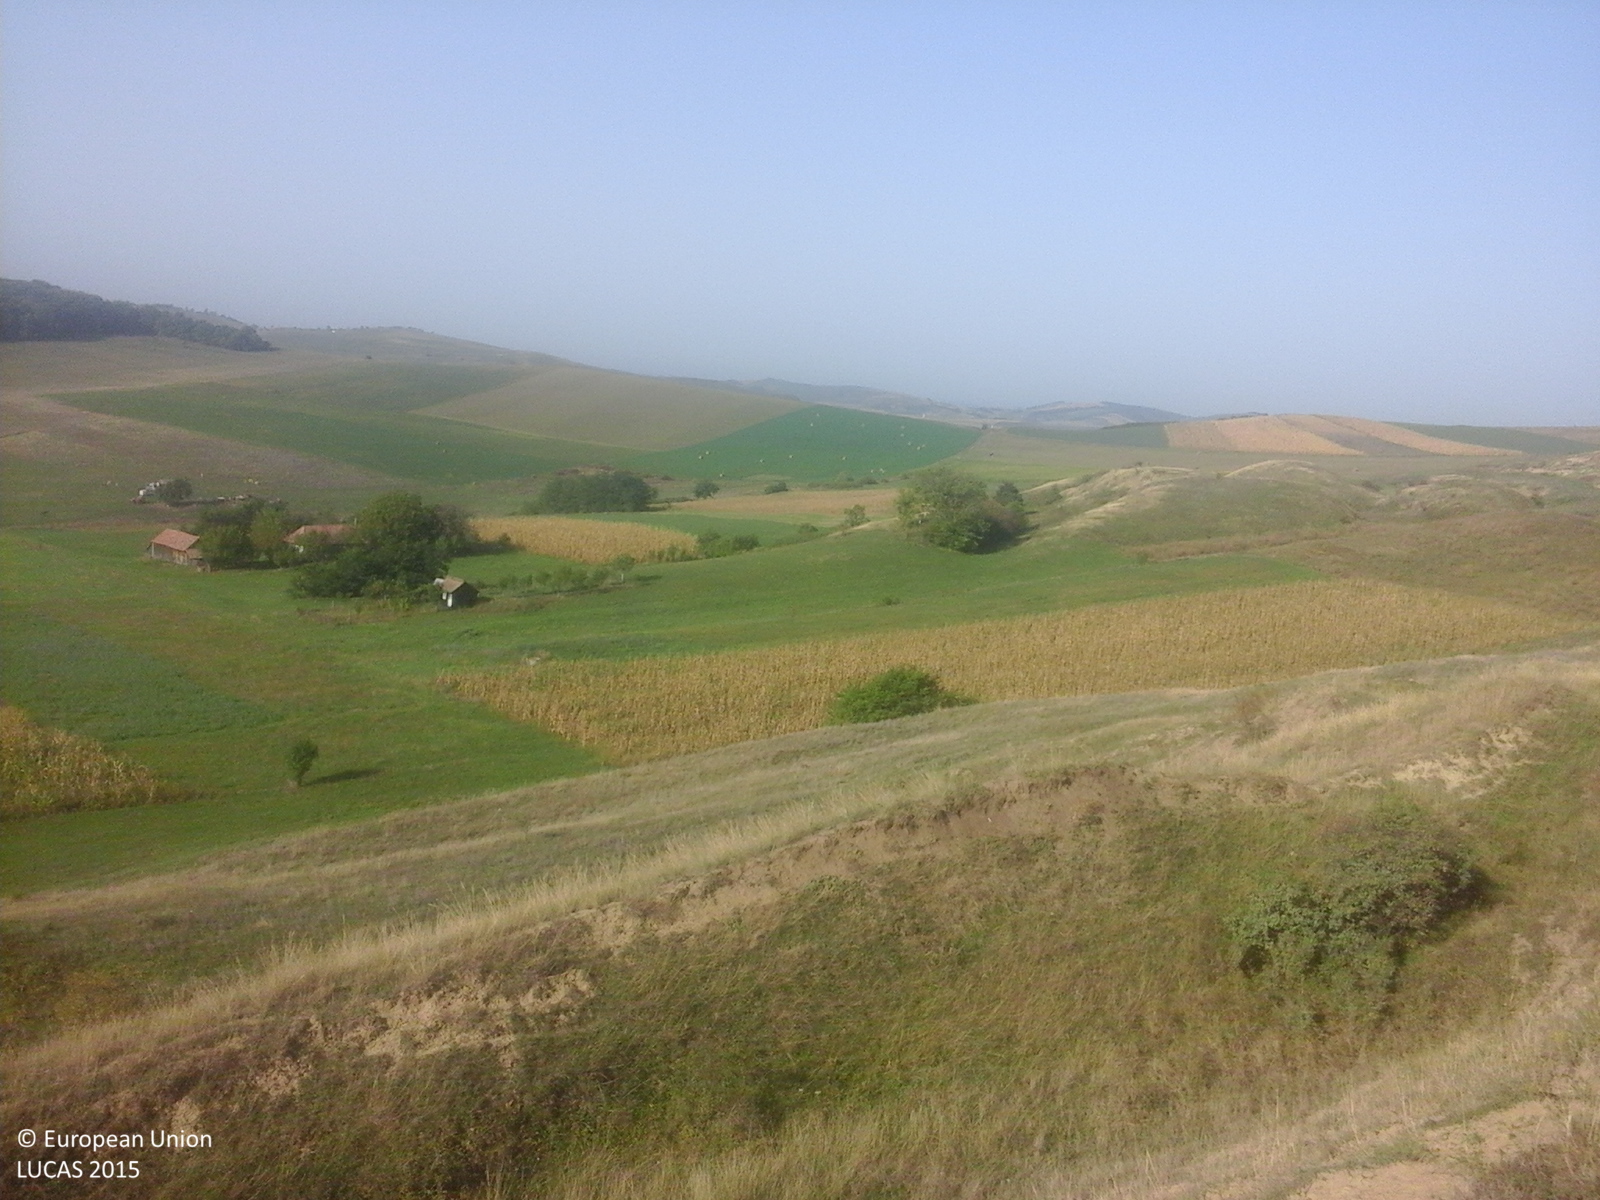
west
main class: Grassland
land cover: Grassland without tree/shrub cover
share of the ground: > 75 %
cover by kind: herbaceous plants 100 %
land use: Agriculture (excluding fallow land and kitchen gardens)
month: September
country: RO
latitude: 46.8306
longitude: 24.2826
